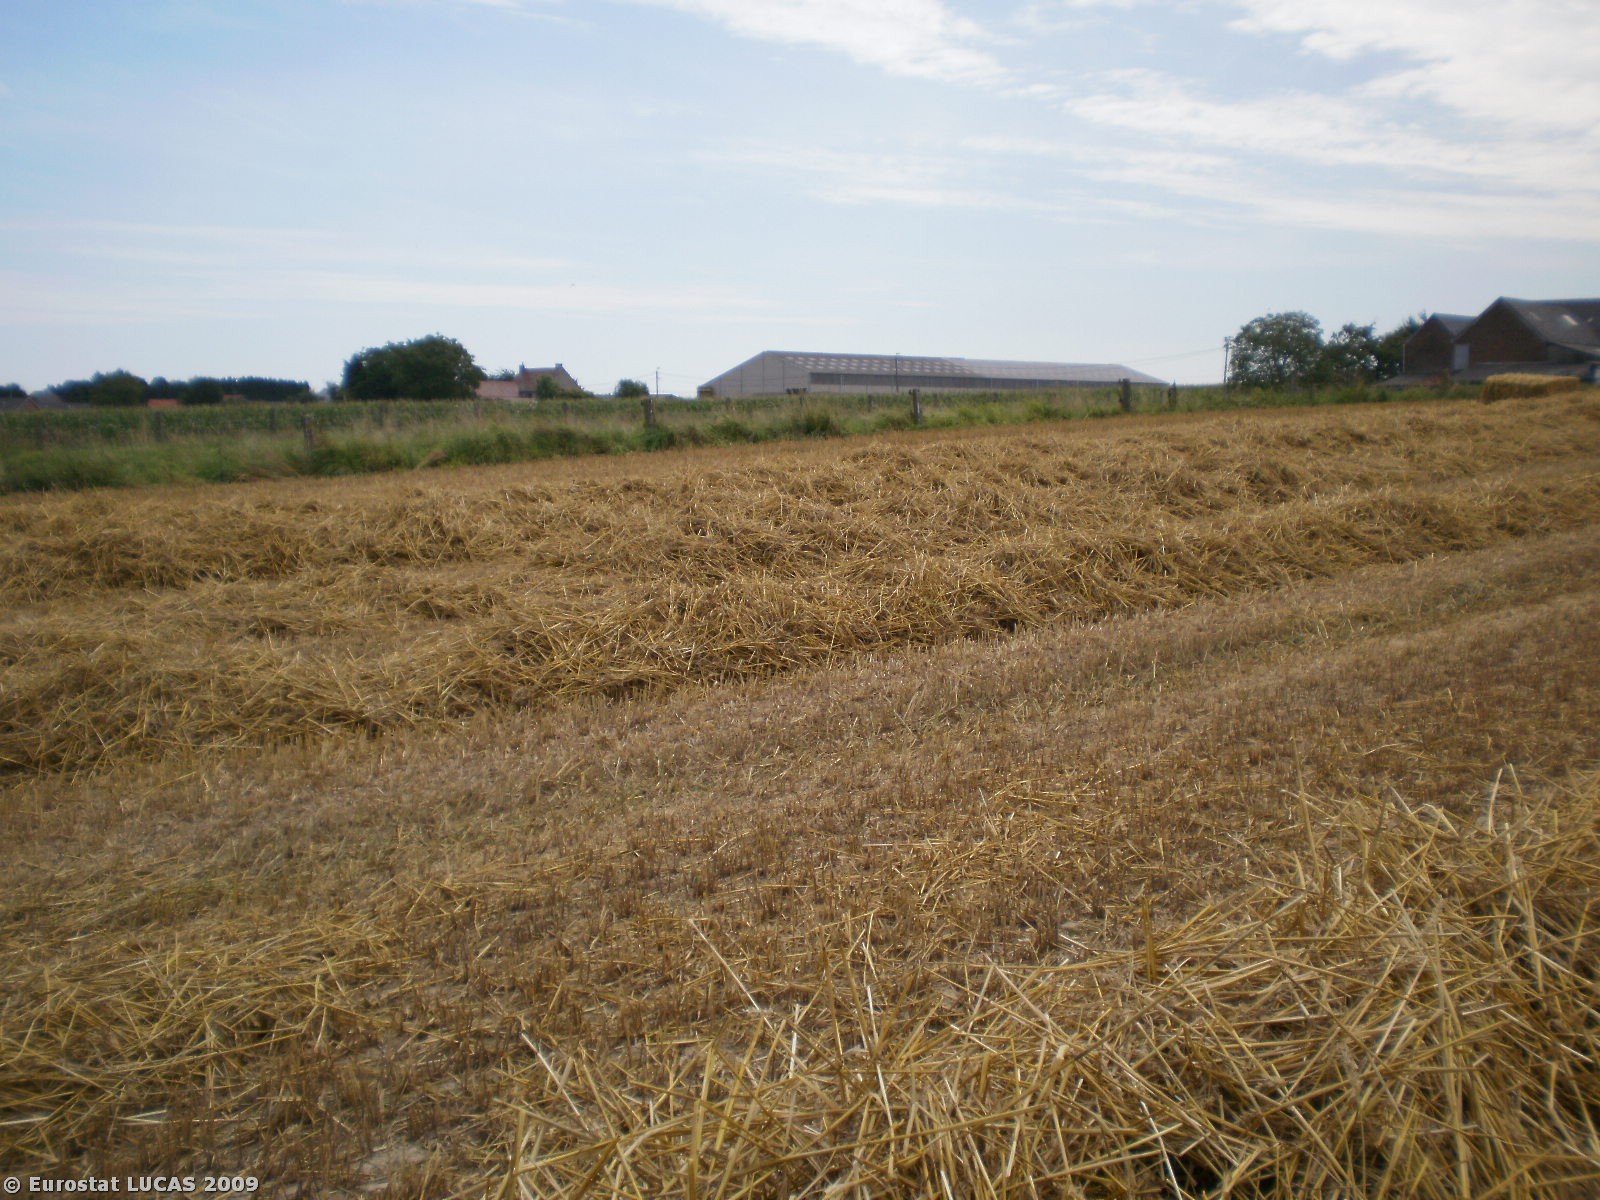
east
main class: Cropland
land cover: Common wheat
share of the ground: > 75 %
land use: Agriculture (excluding fallow land and kitchen gardens)
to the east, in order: Common wheat; Fences; Grassland without tree/shrub cover; Fences; Grassland without tree/shrub cover; Fences; Maize; Fences; Grassland without tree/shrub cover; Fences; Grassland without tree/shrub cover
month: August
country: BE
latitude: 50.7564
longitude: 3.8272
